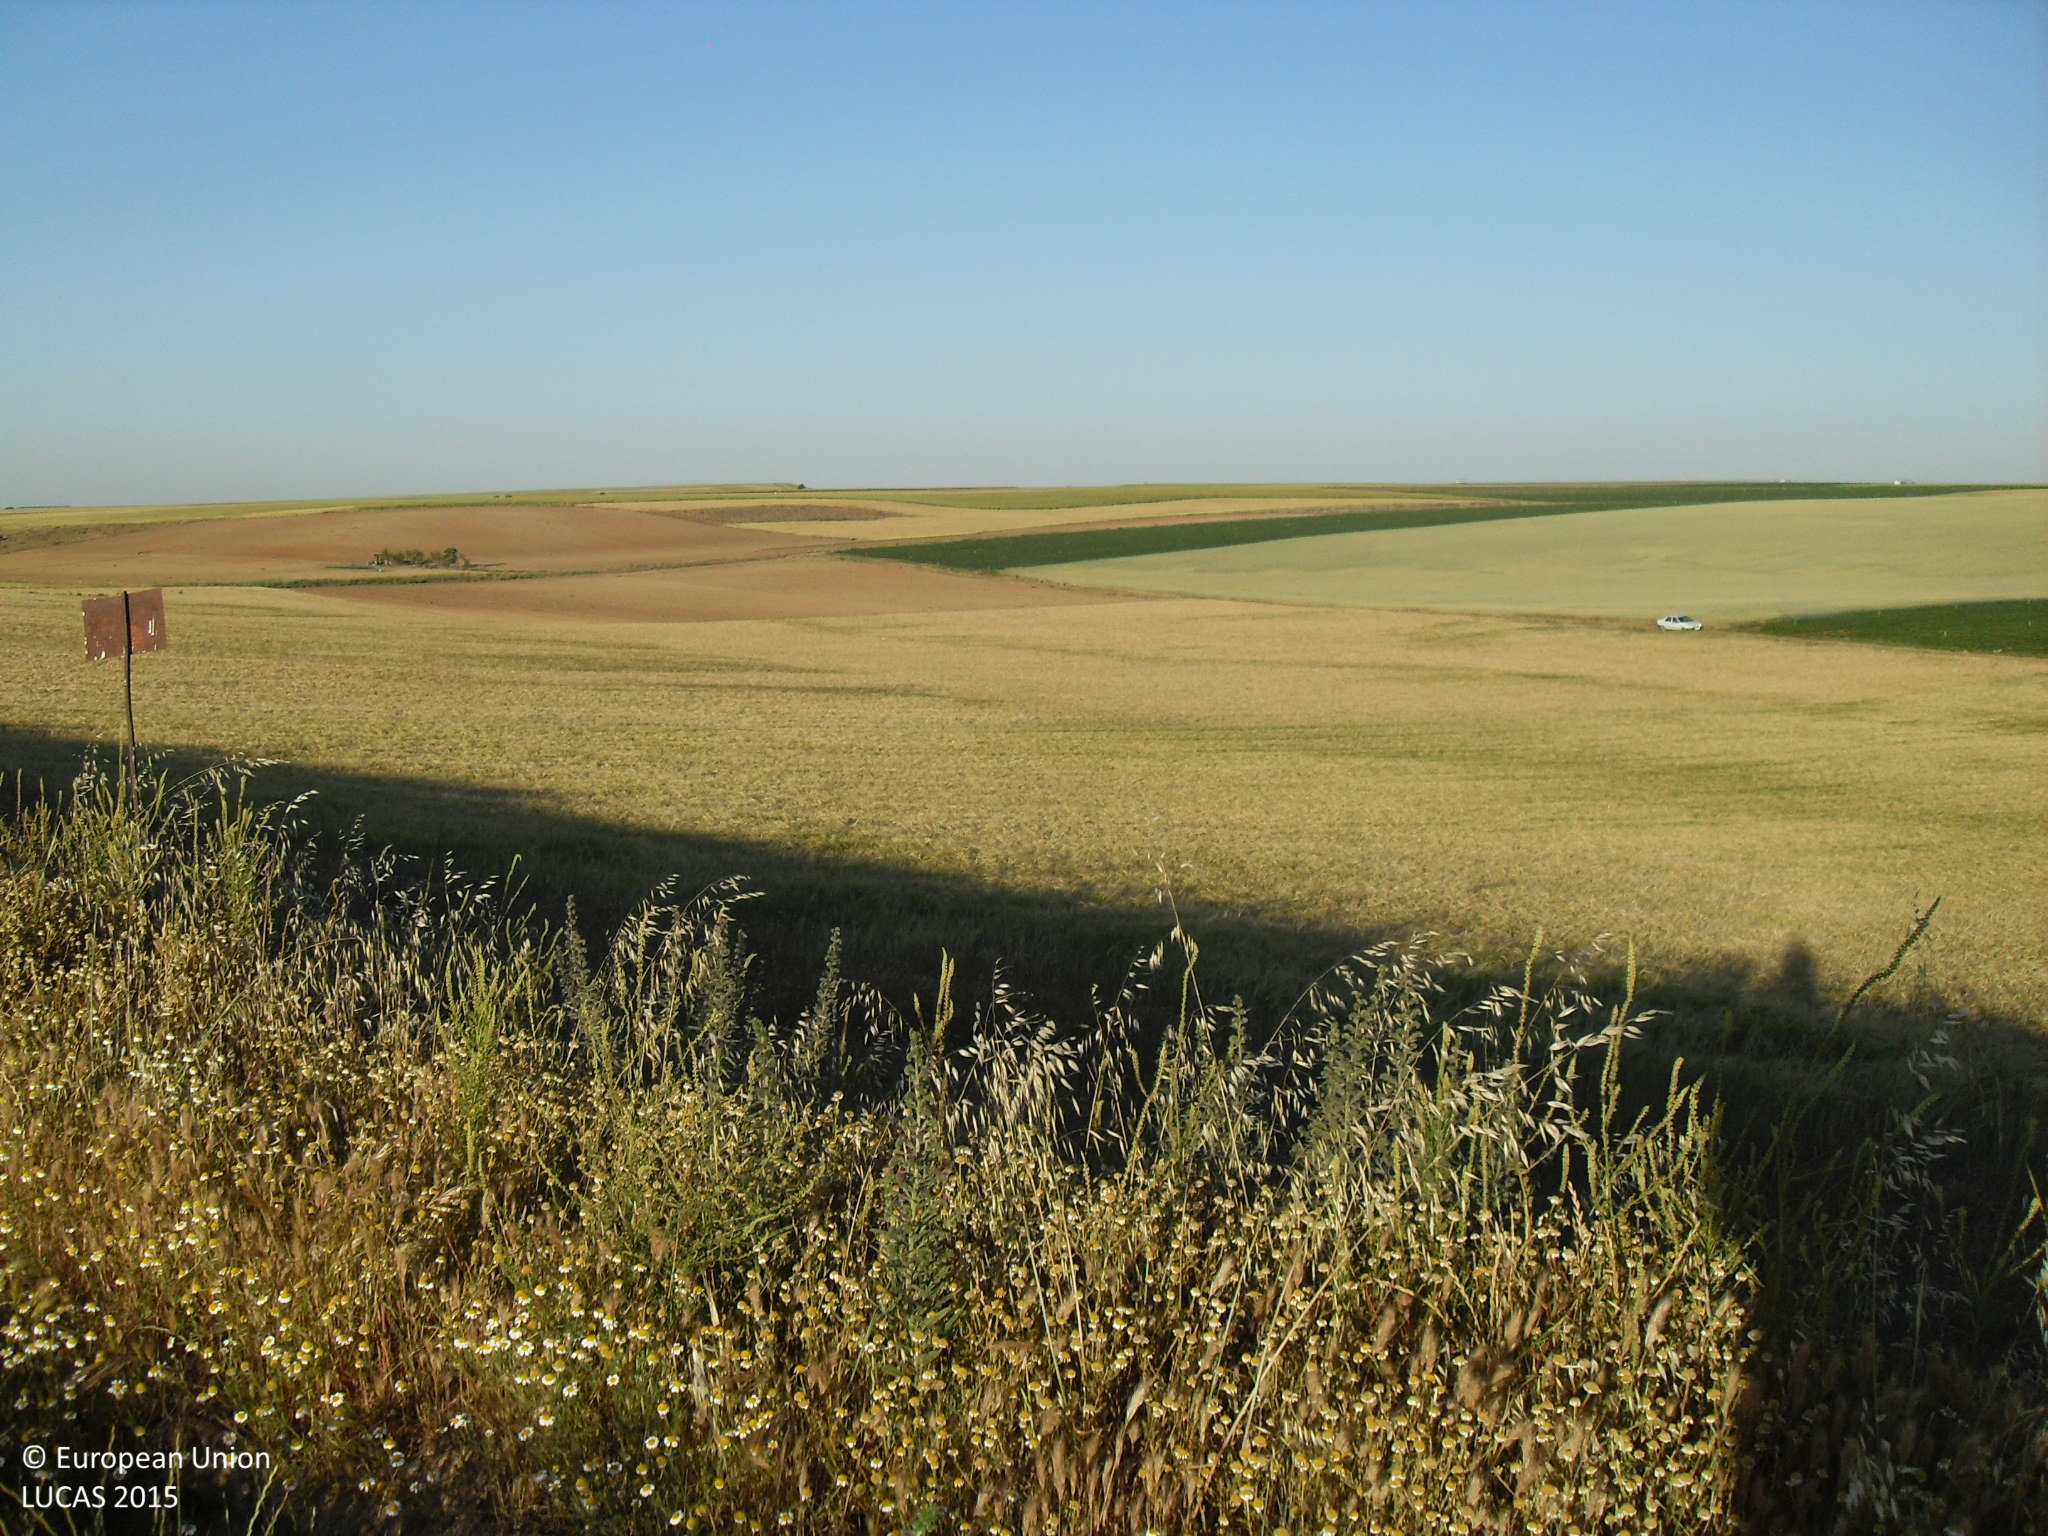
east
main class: Cropland
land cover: Barley
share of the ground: > 75 %
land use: Agriculture (excluding fallow land and kitchen gardens)
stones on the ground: 25 - 50 %
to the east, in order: Barley; Spontaneously vegetated surfaces; Barley; Other bare soil
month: May
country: ES
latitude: 41.0659
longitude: -5.3891
